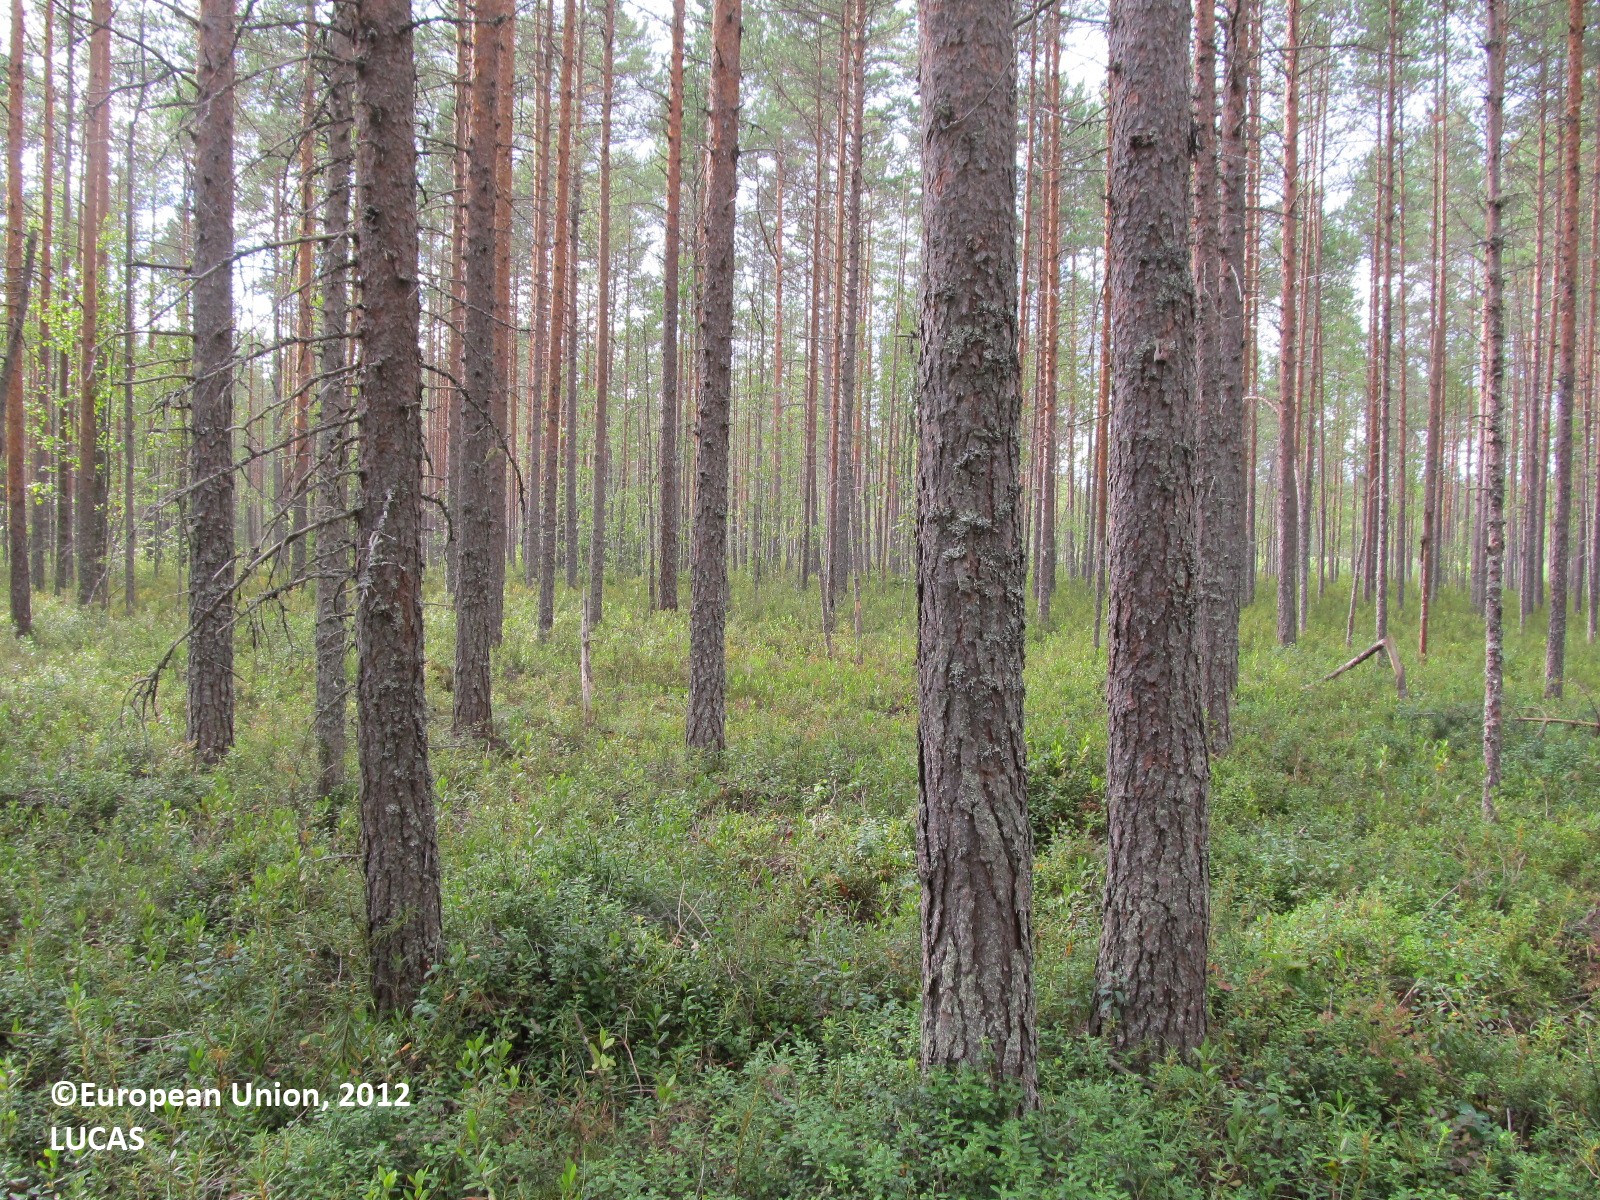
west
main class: Woodland
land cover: Pine dominated coniferous woodland
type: boreal forest
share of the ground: 25 - 50 %
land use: Forestry
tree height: > 5 m
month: August
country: FI
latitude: 62.2922
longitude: 28.4589
